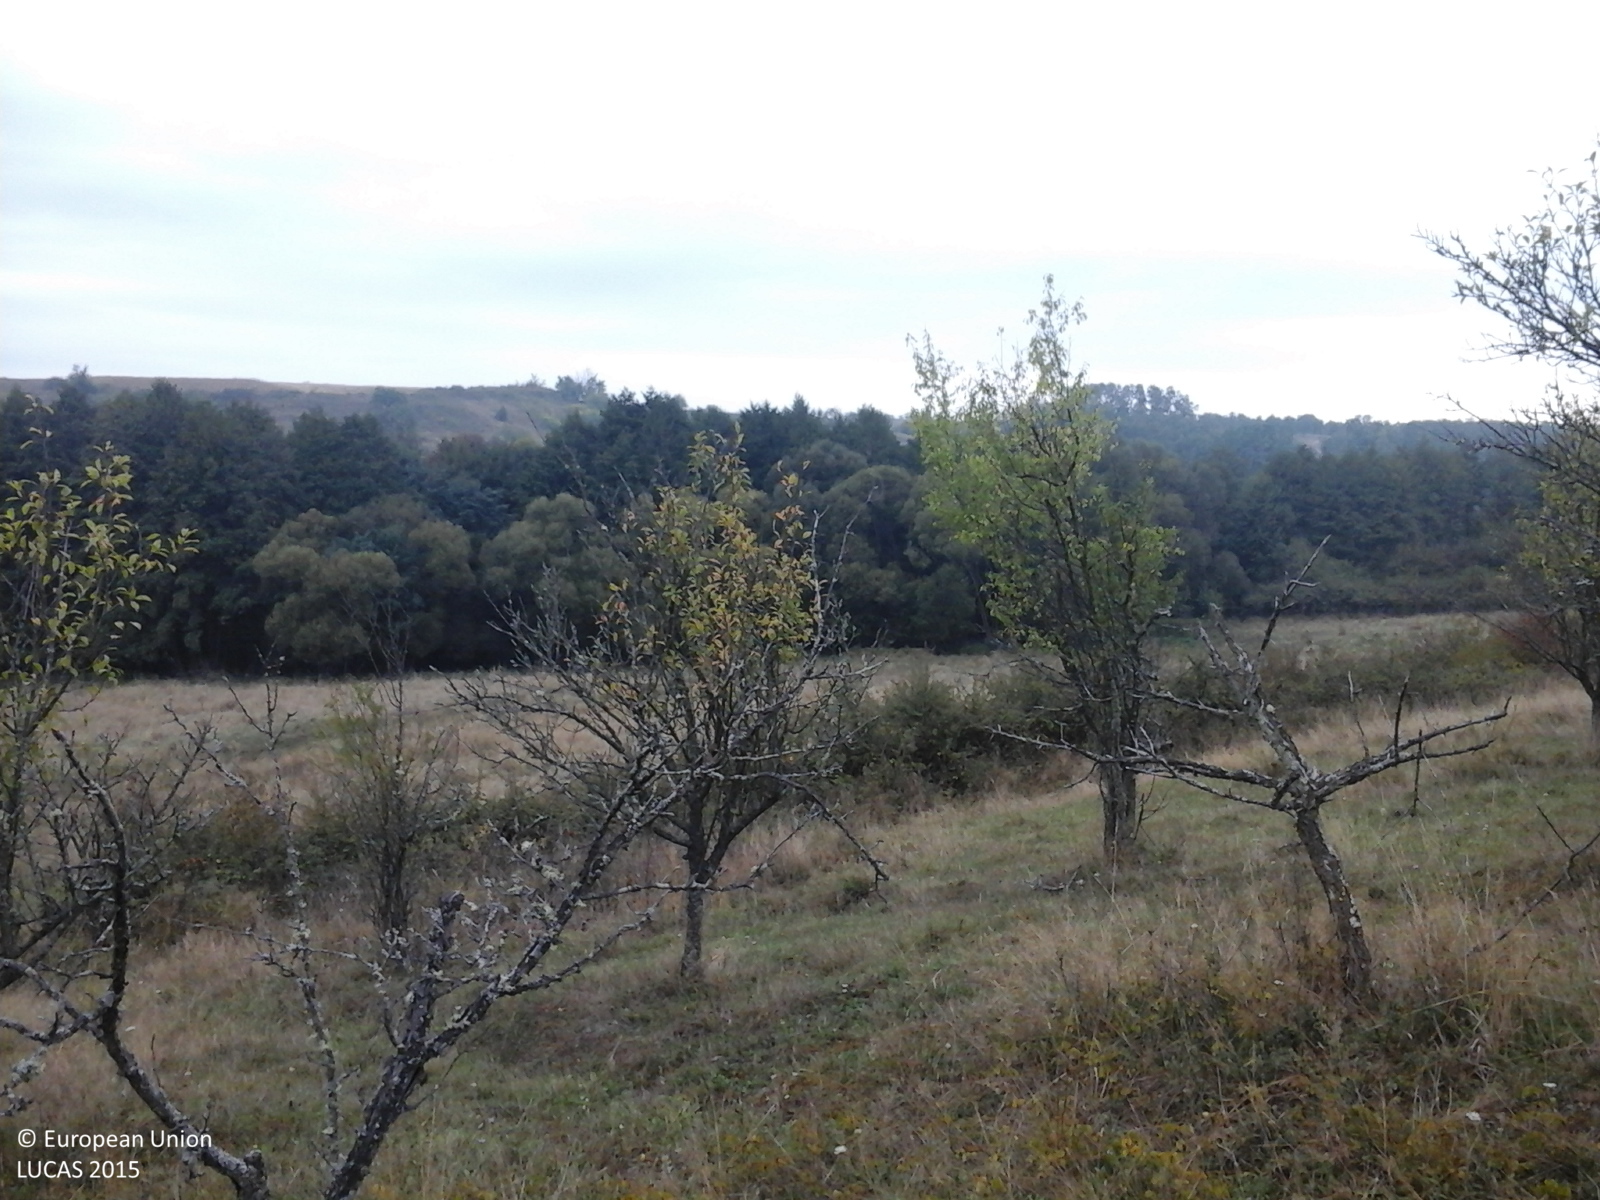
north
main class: Cropland
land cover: Apple fruit
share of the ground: > 75 %
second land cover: Grassland without tree/shrub cover
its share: > 75 %
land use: Agriculture (excluding fallow land and kitchen gardens)
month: September
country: RO
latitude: 45.5261
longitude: 22.0101
